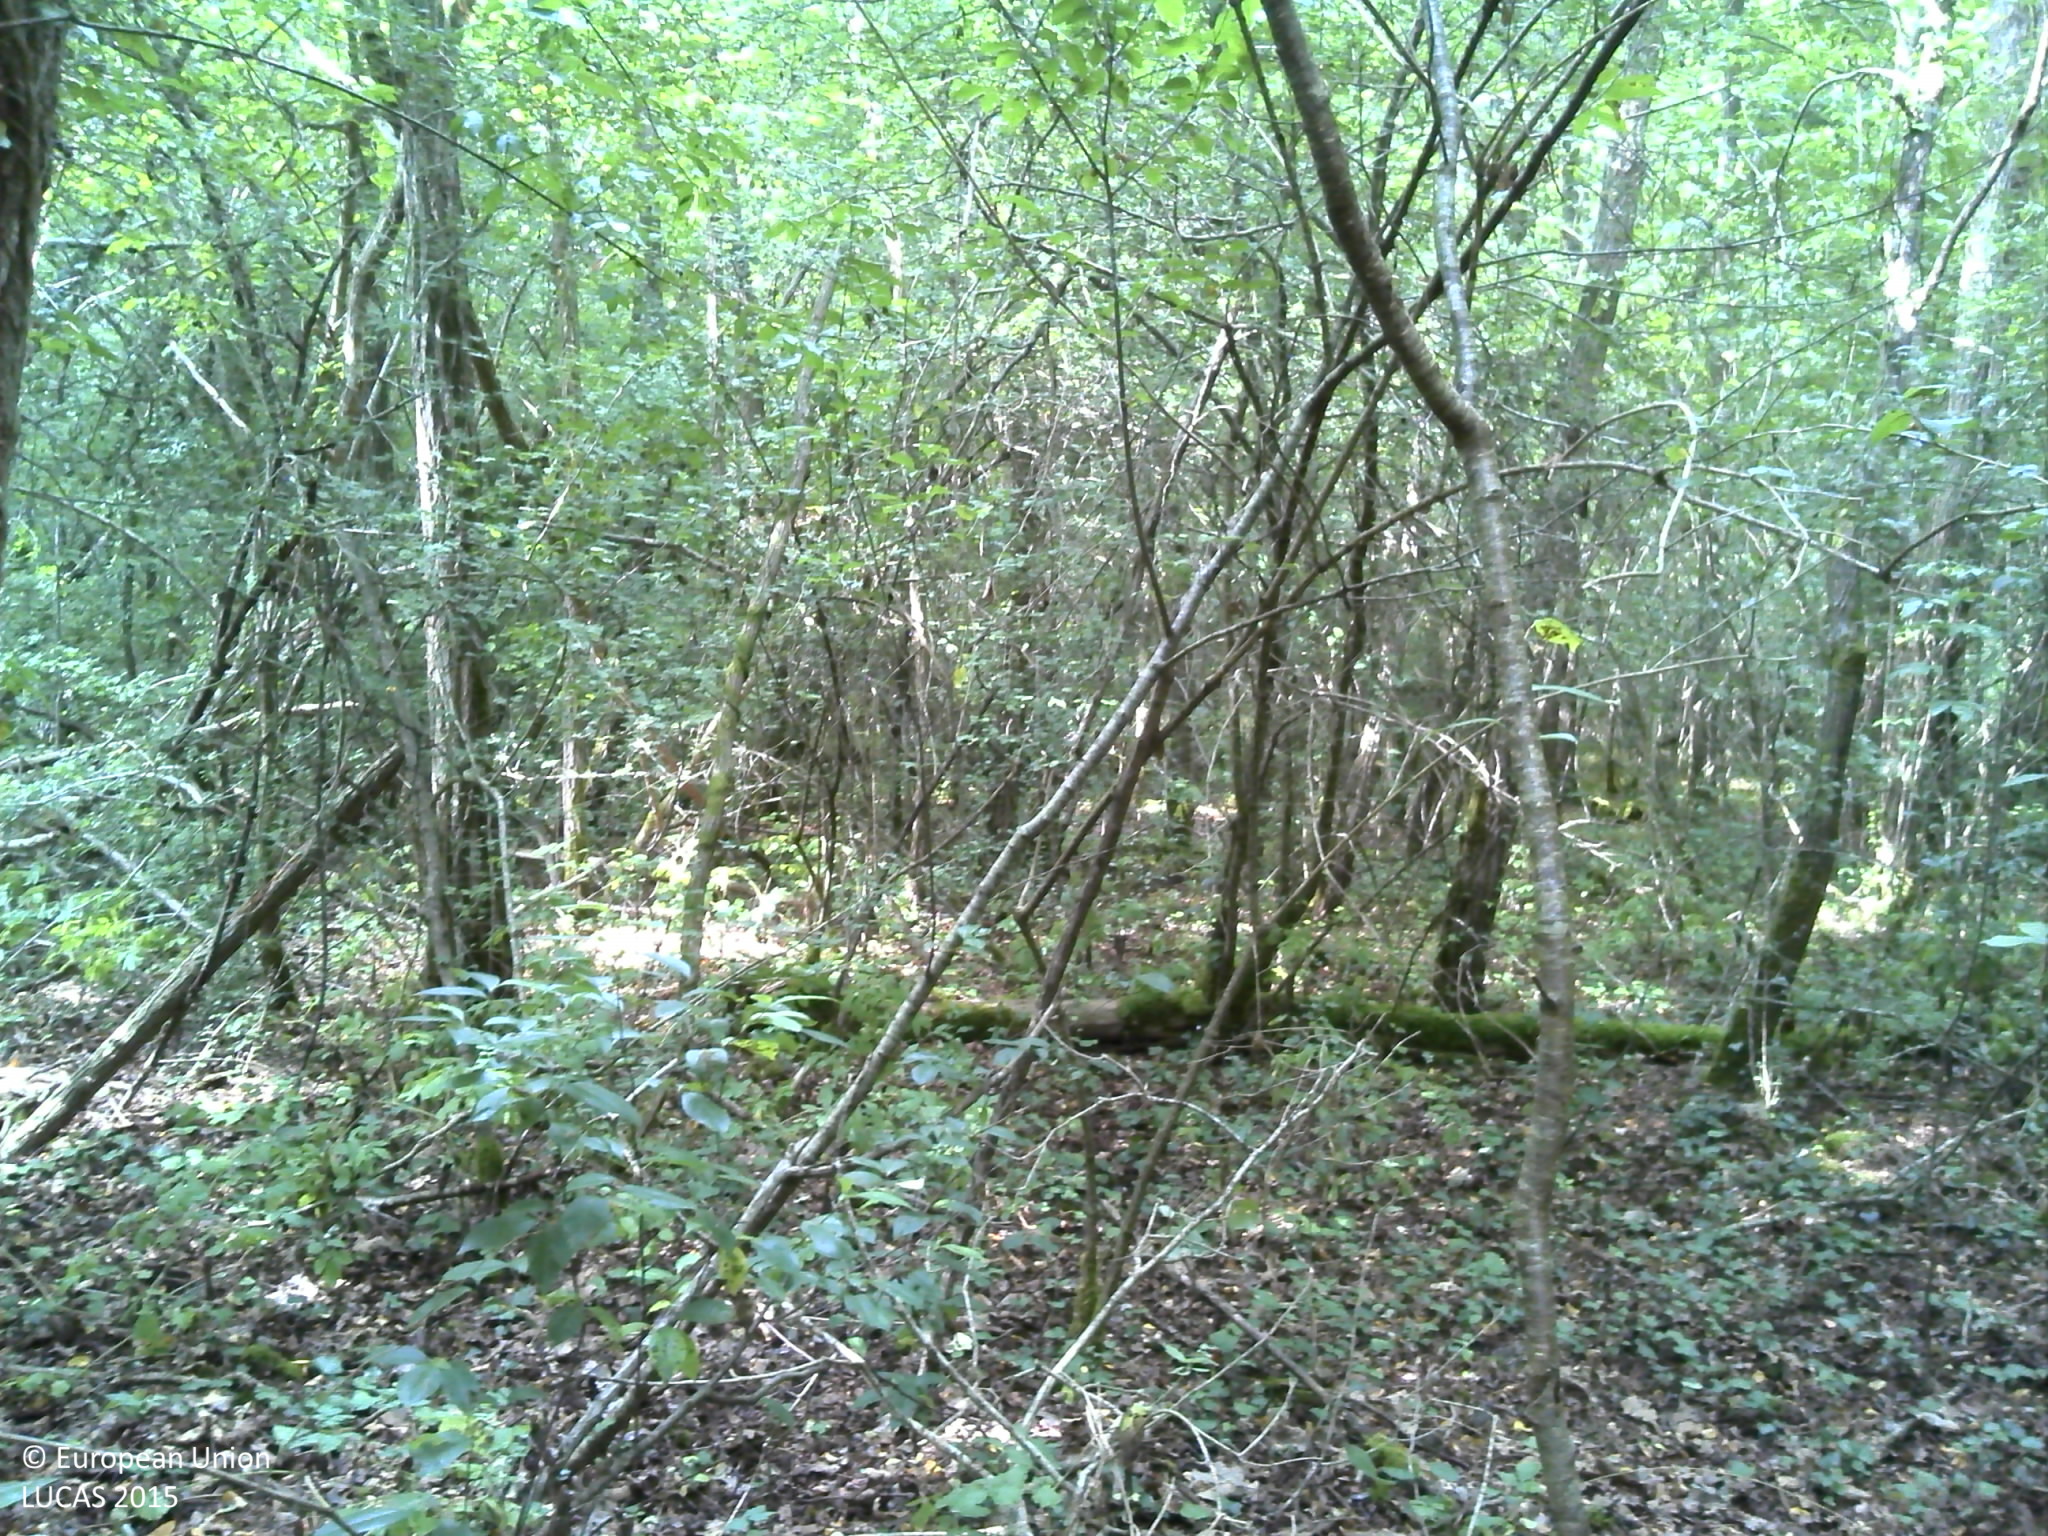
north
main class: Woodland
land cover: Broadleaved woodland
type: acidophilous oak and oak-birch forest
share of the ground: > 75 %
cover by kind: broadleaved forest trees 60 %, shrubs 30 %, herbaceous plants 5 %, lichens and mosses 5 %
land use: Forestry
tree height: > 5 m
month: July
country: FR
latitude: 44.5534
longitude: -0.4007
